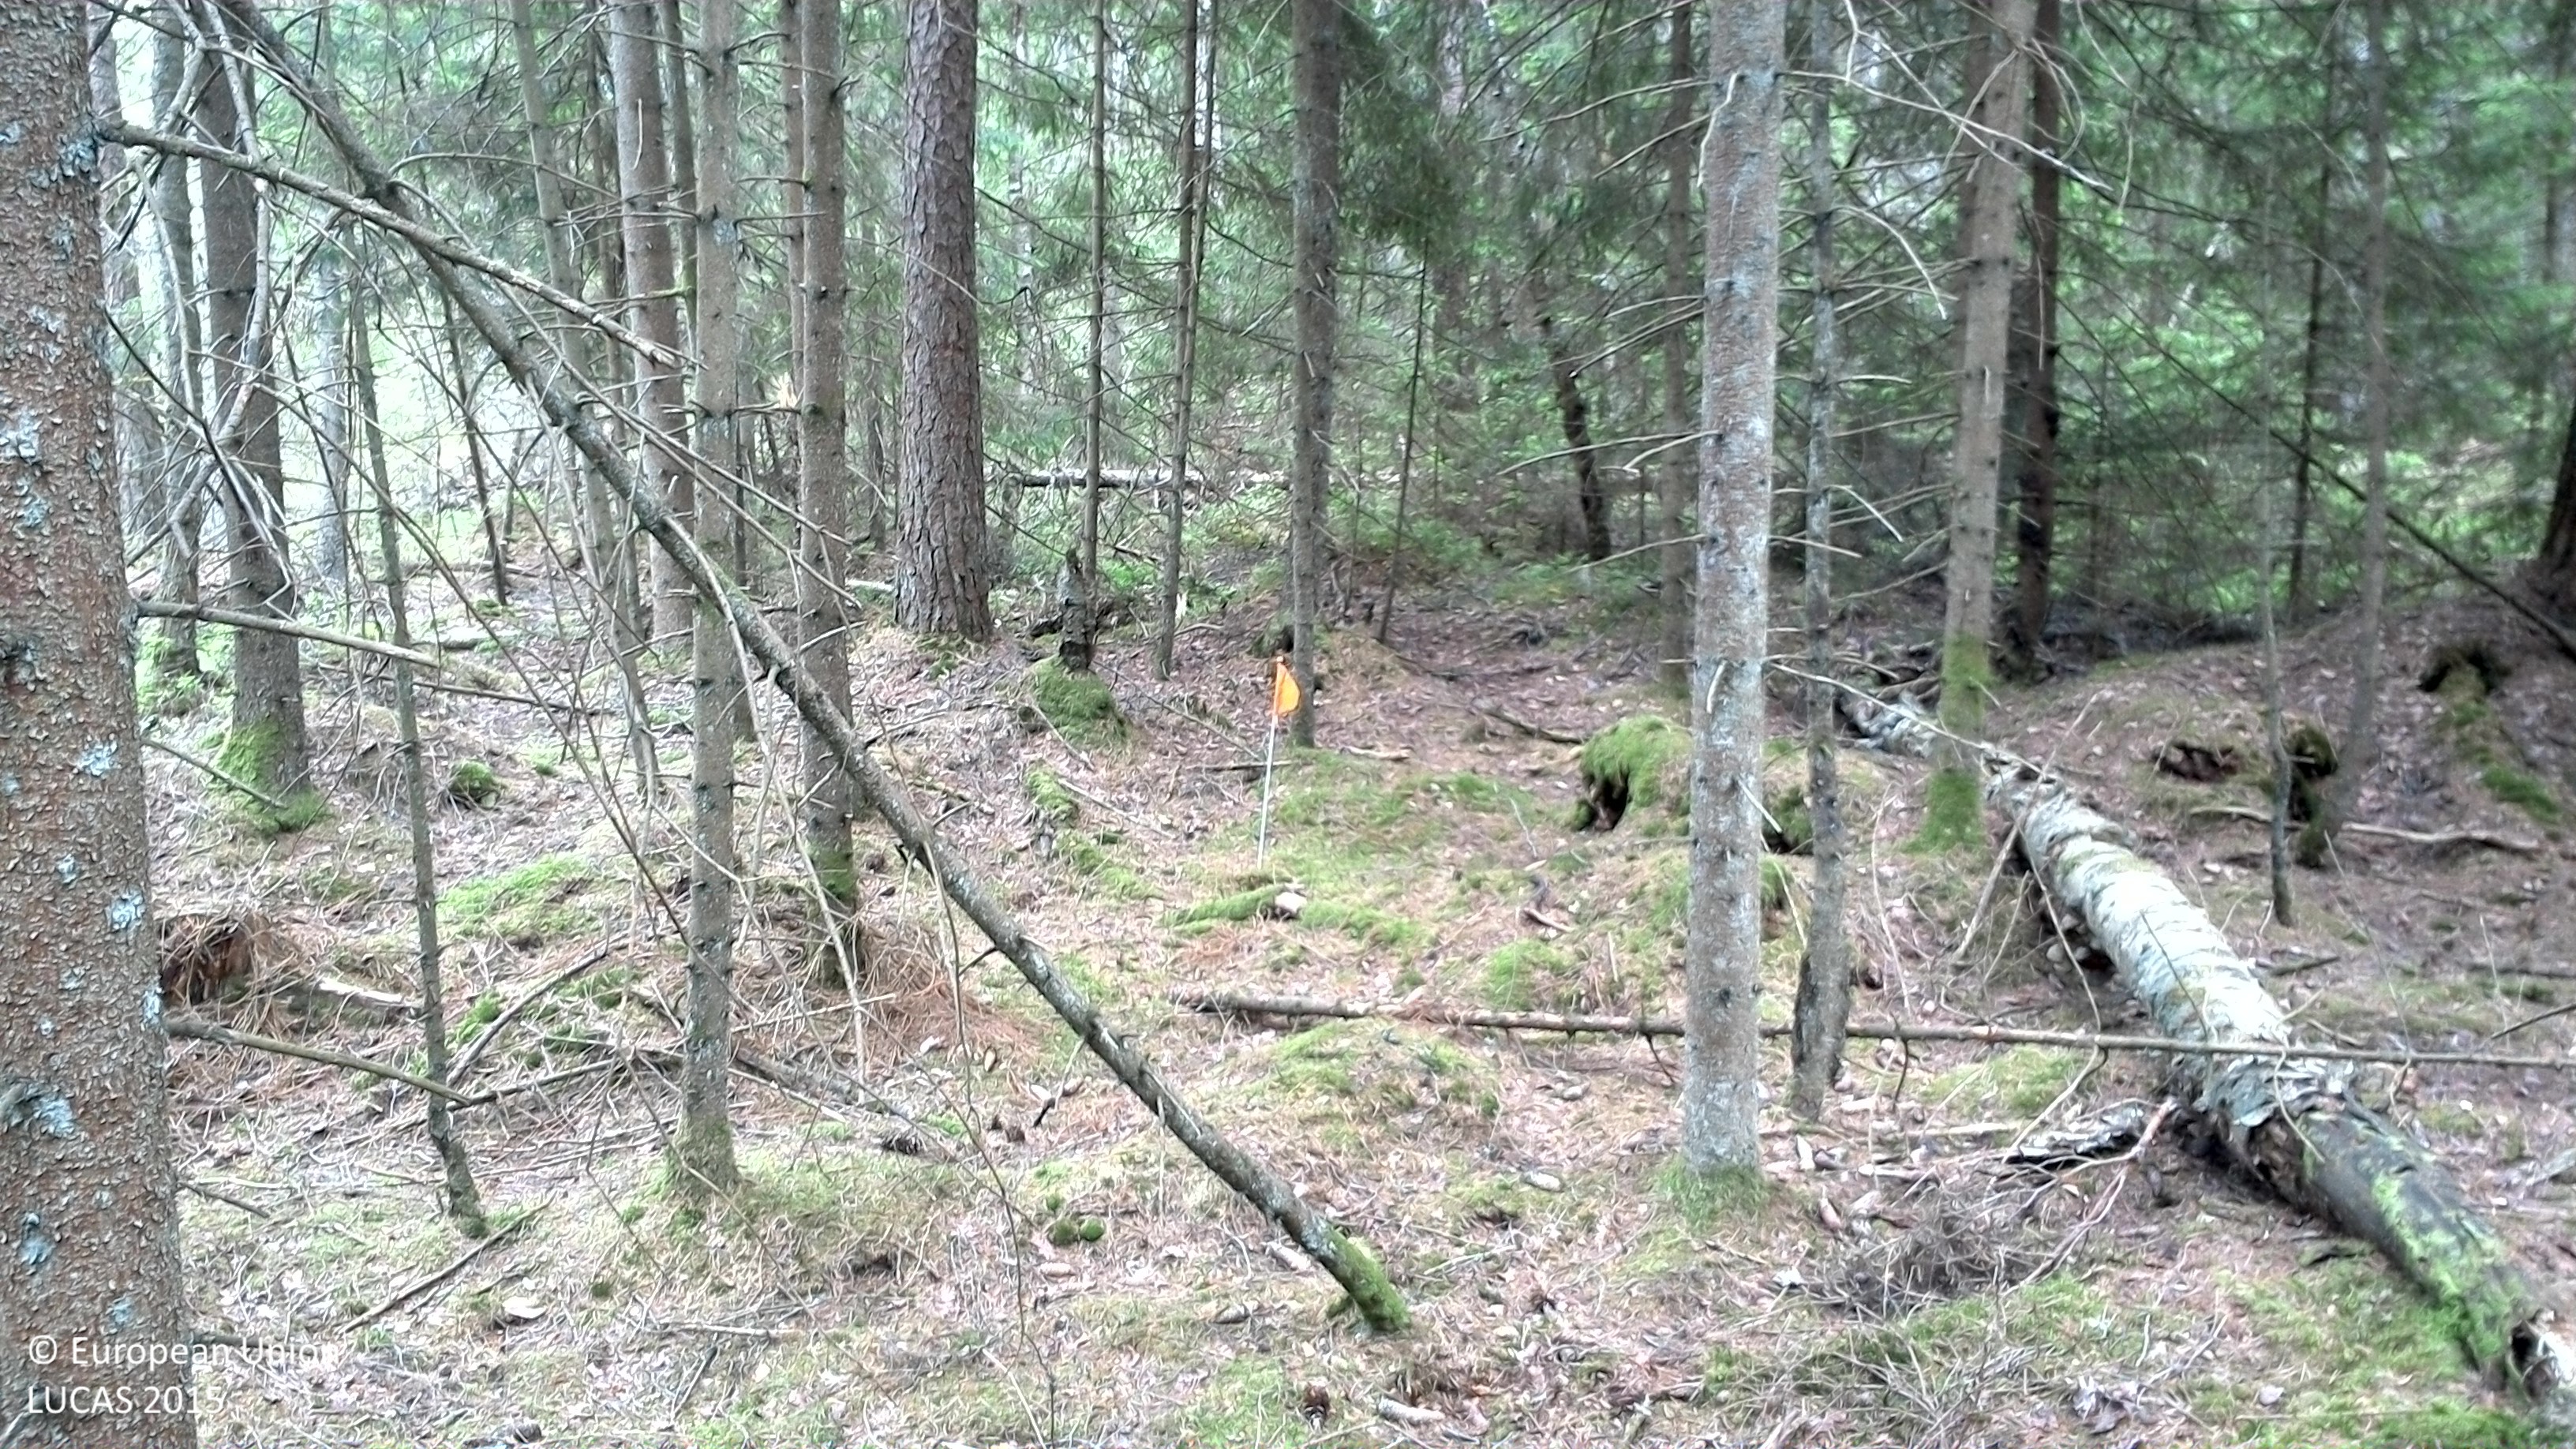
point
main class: Woodland
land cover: Spruce dominated coniferous woodland
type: boreal forest
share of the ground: 50 - 75 %
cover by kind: coniferous forest trees 75 %, lichens and mosses 15 %, shrubs 10 %
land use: Forestry
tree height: > 5 m
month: July
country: SE
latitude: 56.4093
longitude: 15.1360
